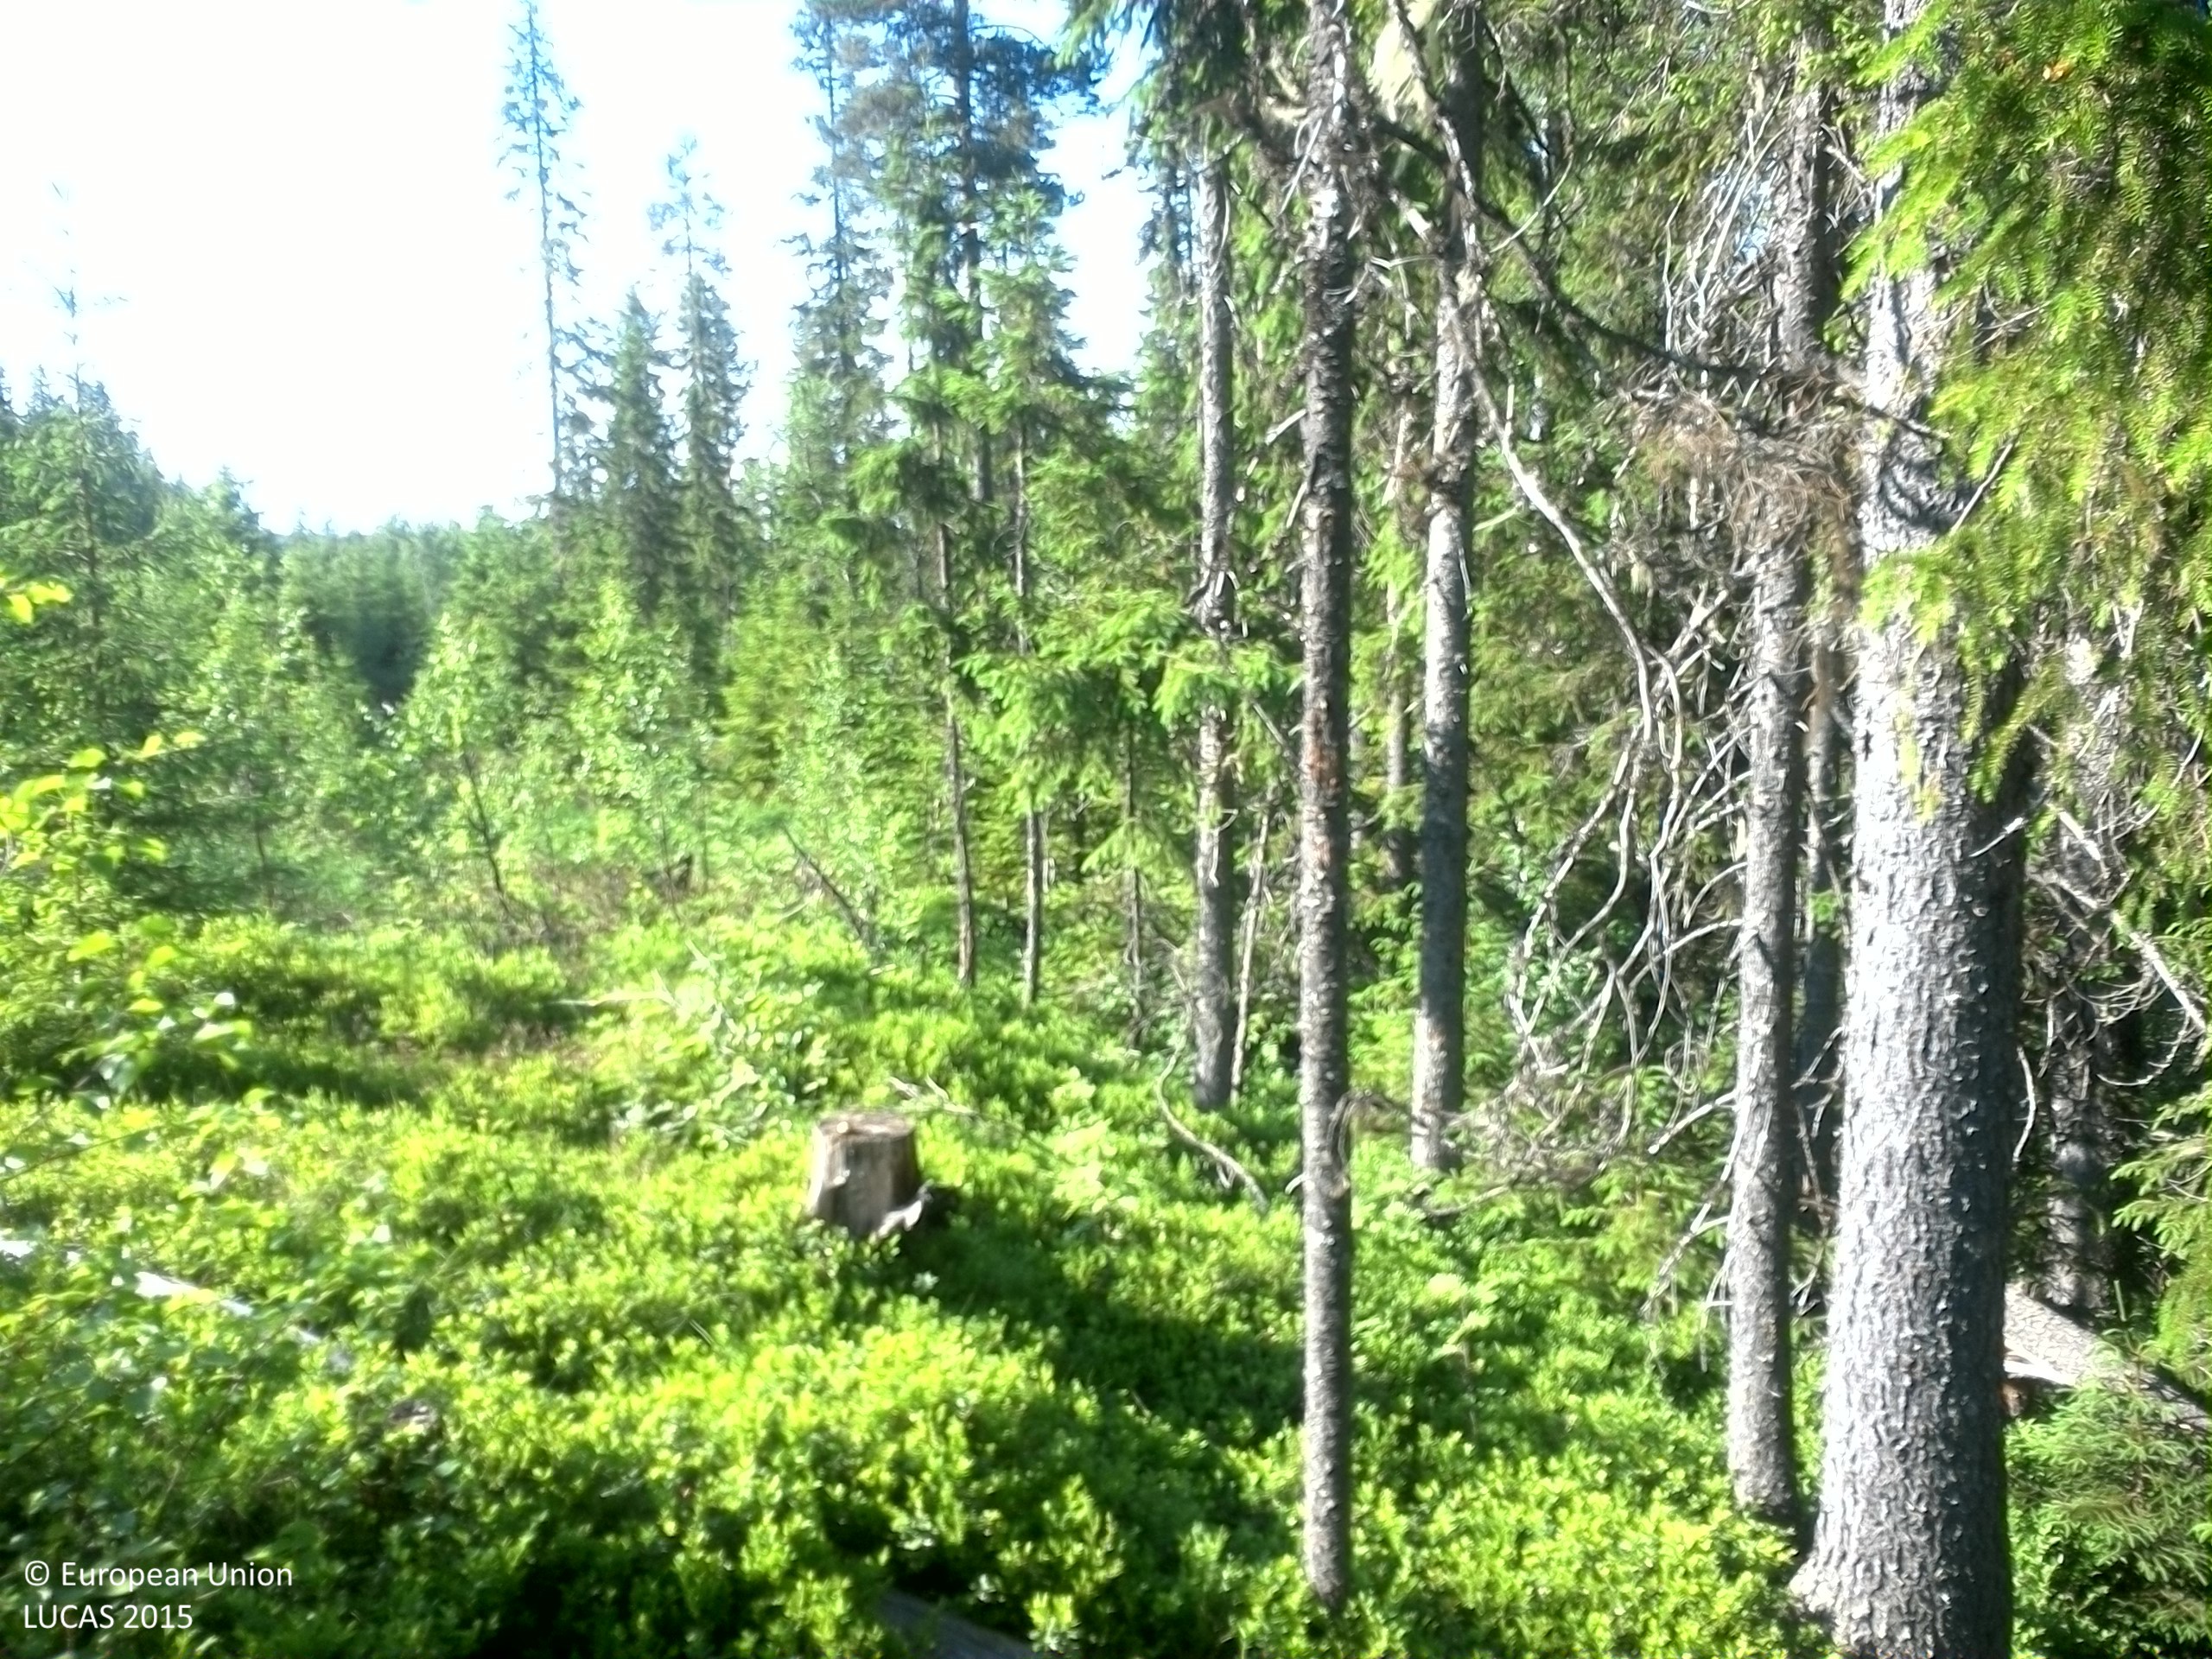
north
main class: Woodland
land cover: Spruce dominated mixed woodland
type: boreal forest
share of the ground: 25 - 50 %
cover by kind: shrubs 60 %, coniferous forest trees 30 %, broadleaved forest trees 10 %
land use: Forestry
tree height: < 5 m
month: July
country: SE
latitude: 62.7980
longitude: 17.2920
